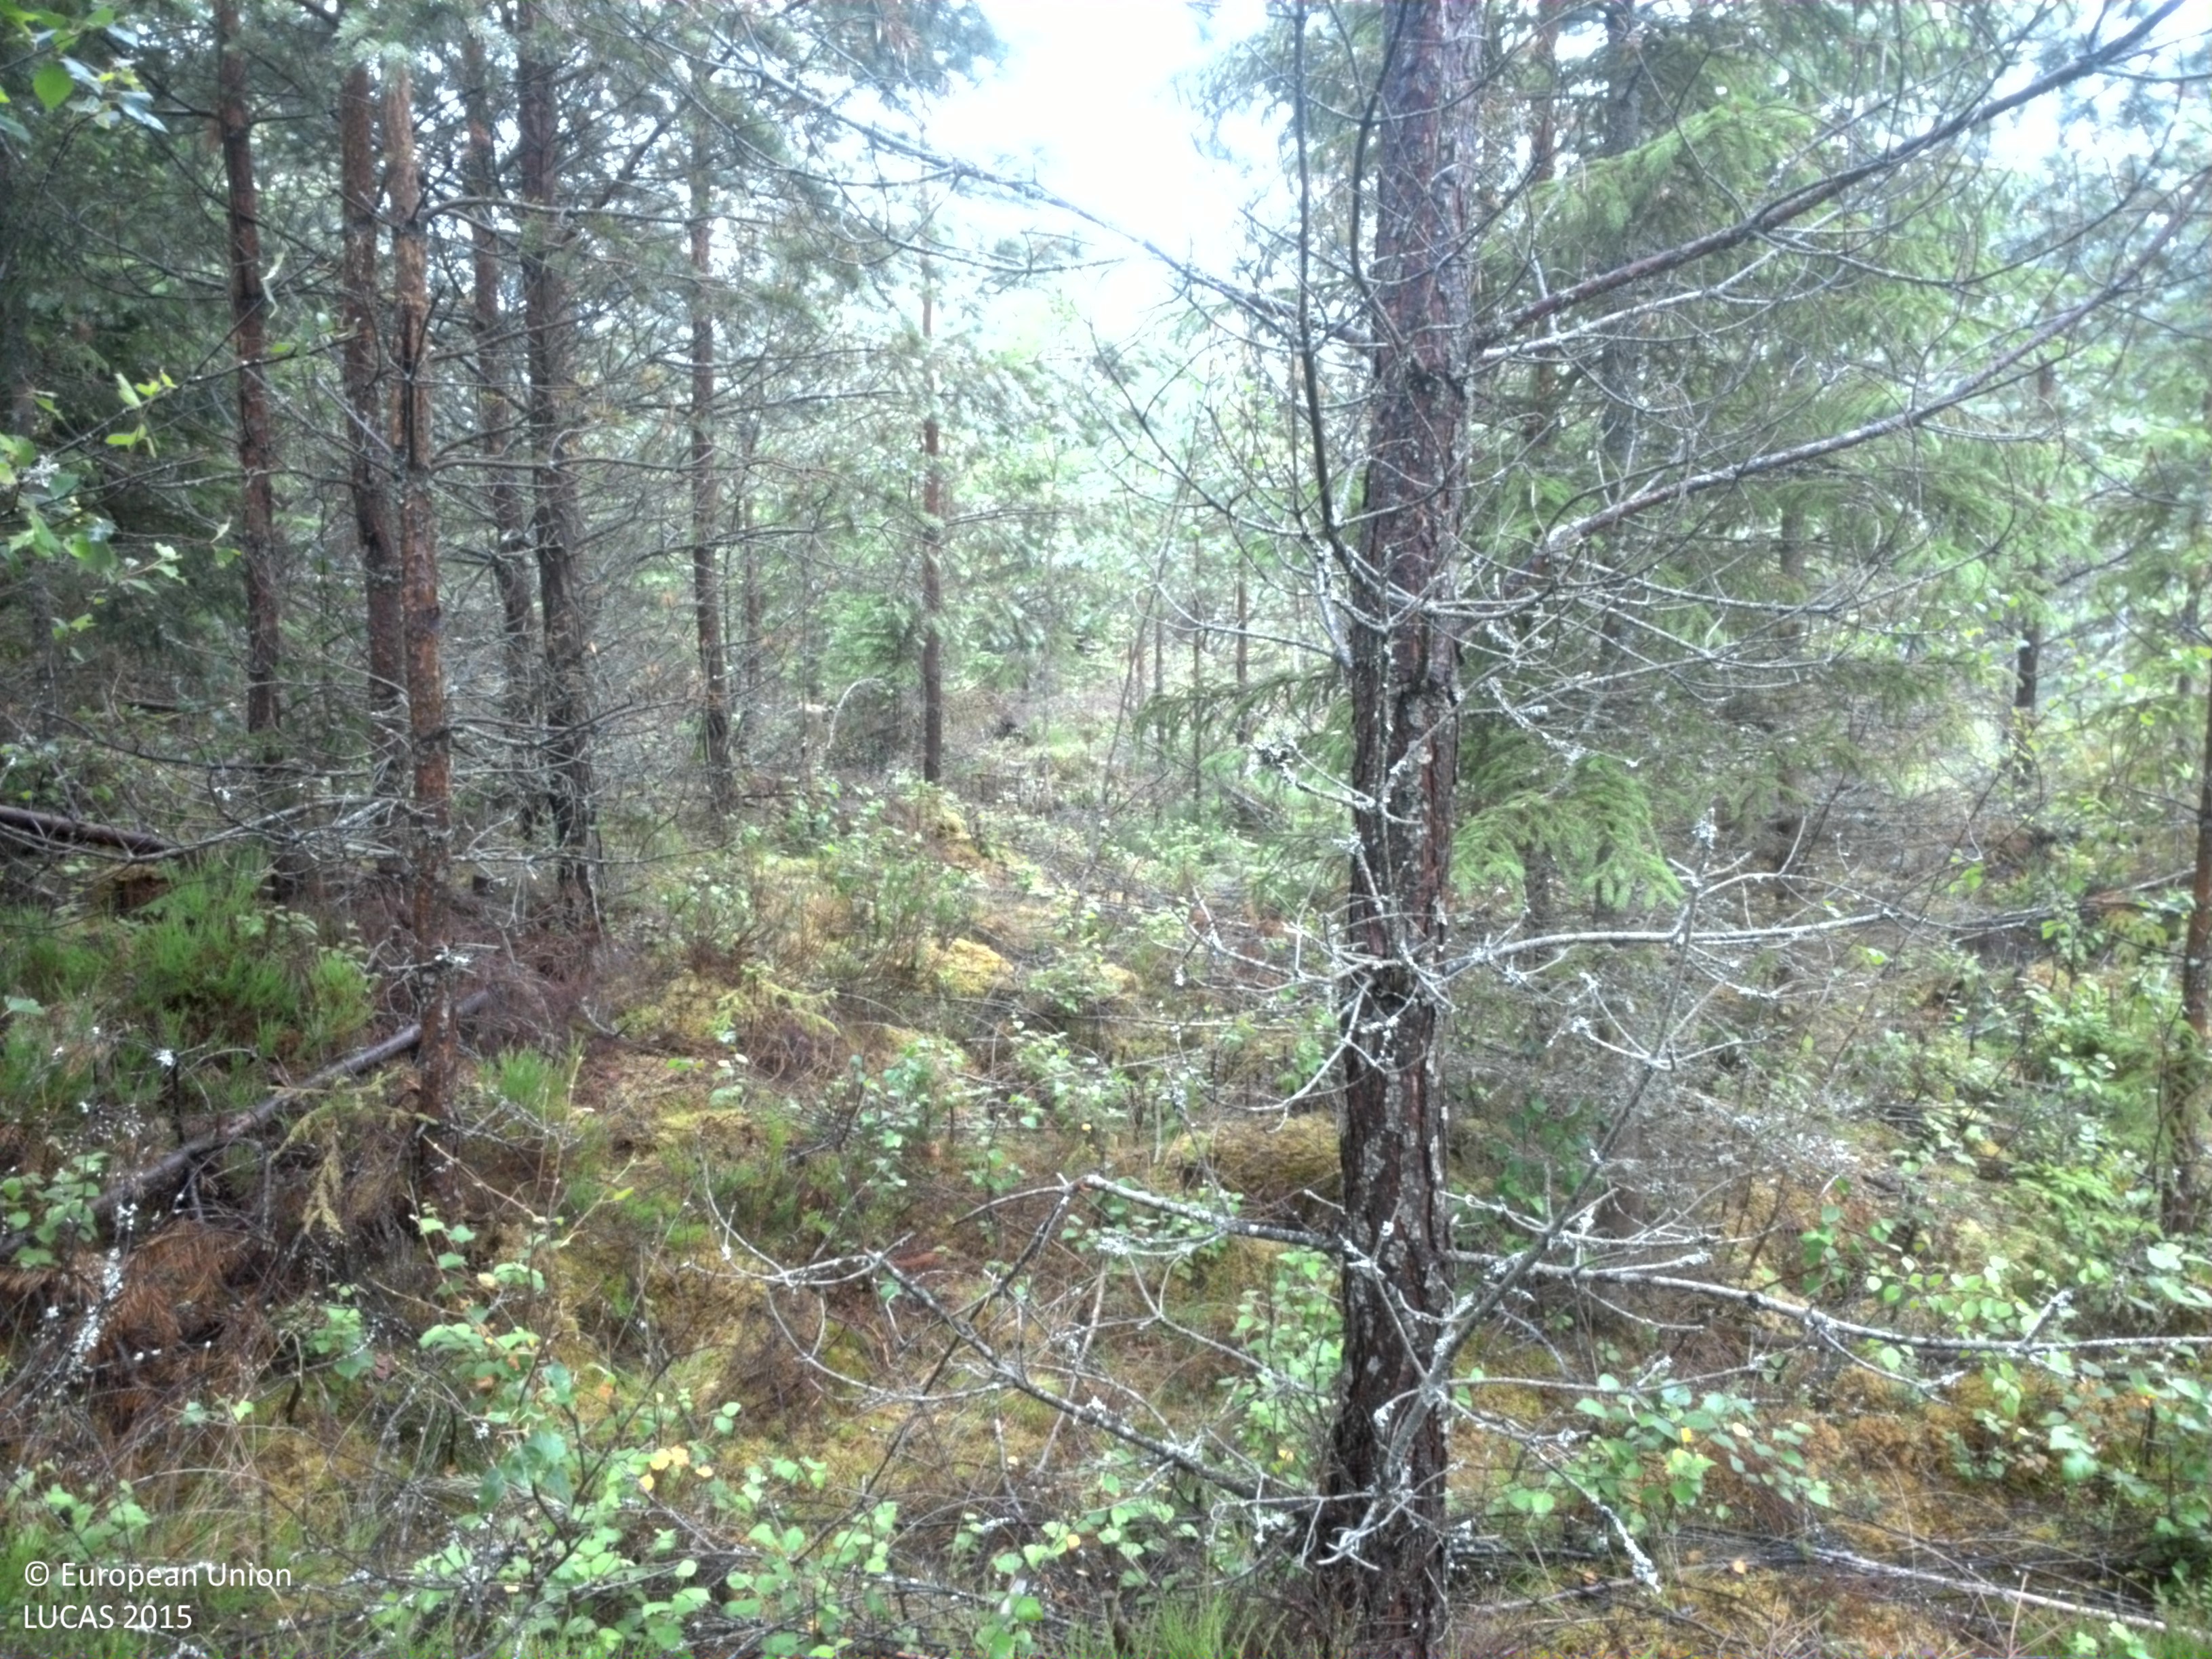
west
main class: Woodland
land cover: Other coniferous woodland
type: boreal forest
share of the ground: > 75 %
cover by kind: coniferous forest trees 70 %, broadleaved forest trees 10 %, shrubs 10 %, lichens and mosses 10 %
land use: Forestry
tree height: > 5 m
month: July
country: SE
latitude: 59.2558
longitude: 14.6741
